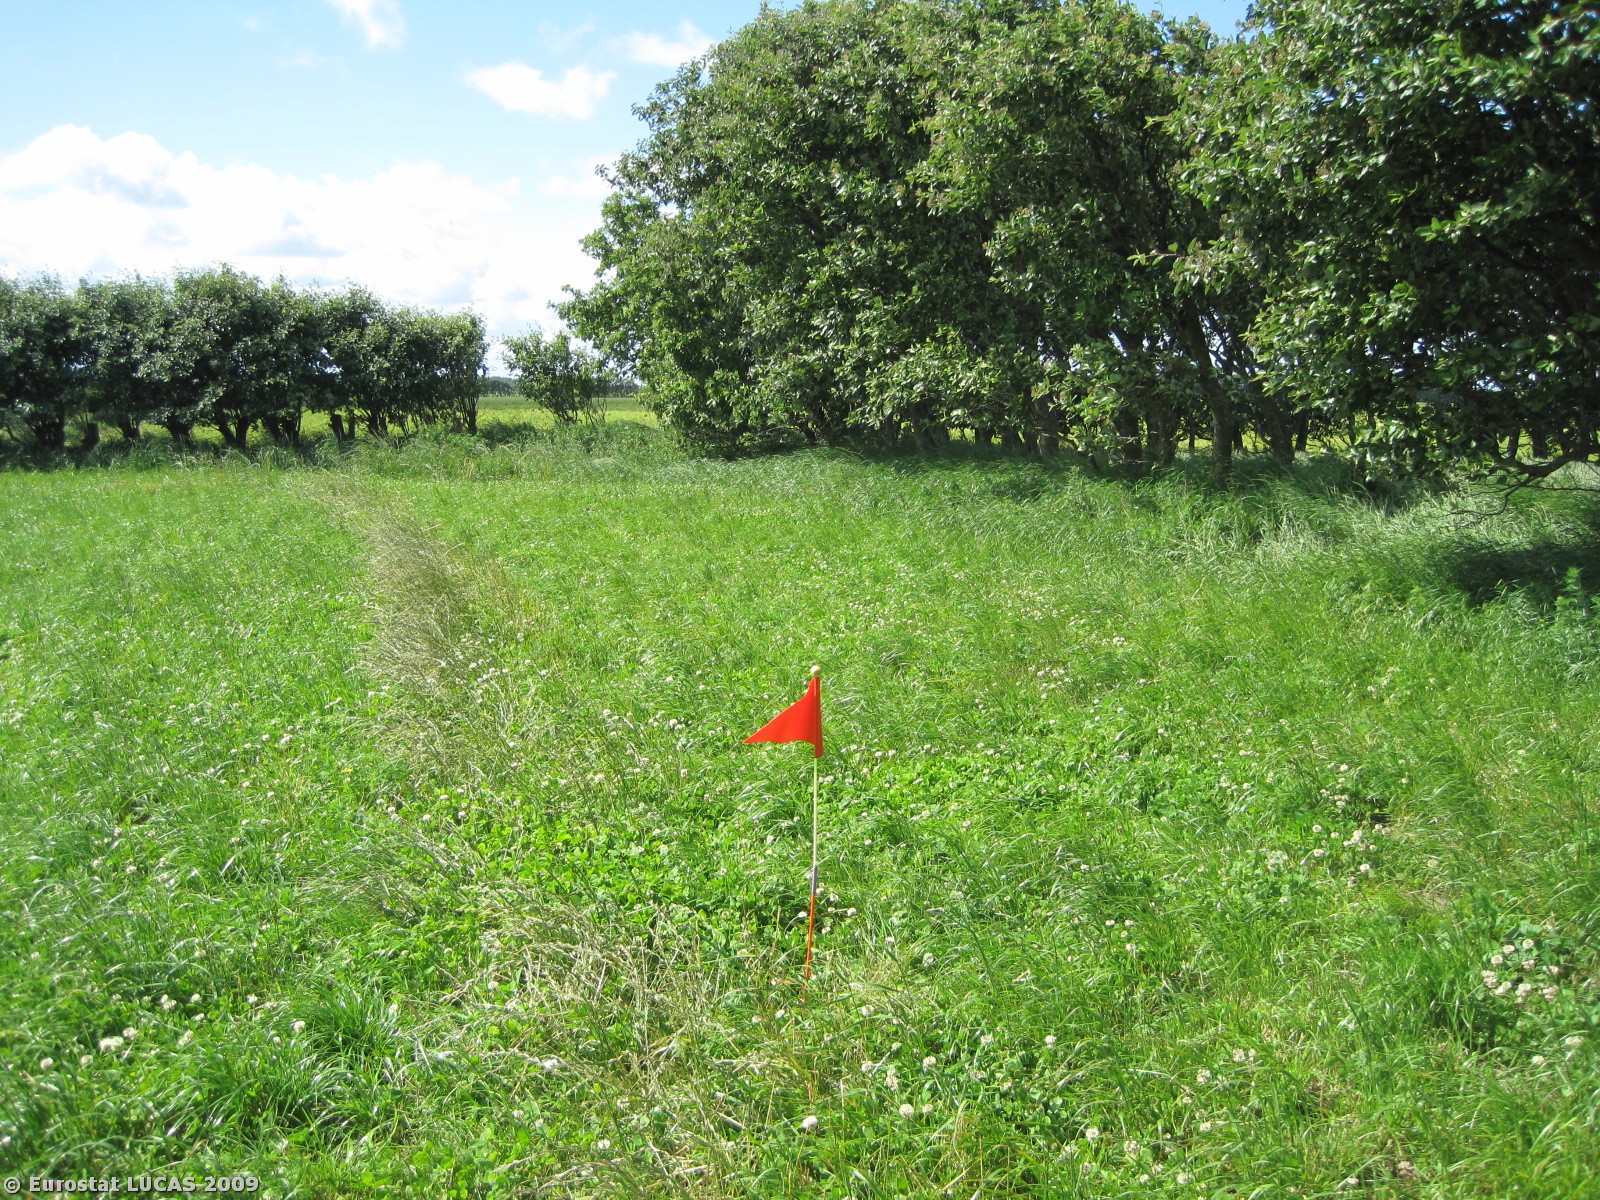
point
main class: Grassland
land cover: Grassland without tree/shrub cover
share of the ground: > 75 %
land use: Agriculture (excluding fallow land and kitchen gardens)
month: June
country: DK
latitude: 56.8866
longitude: 9.2297
